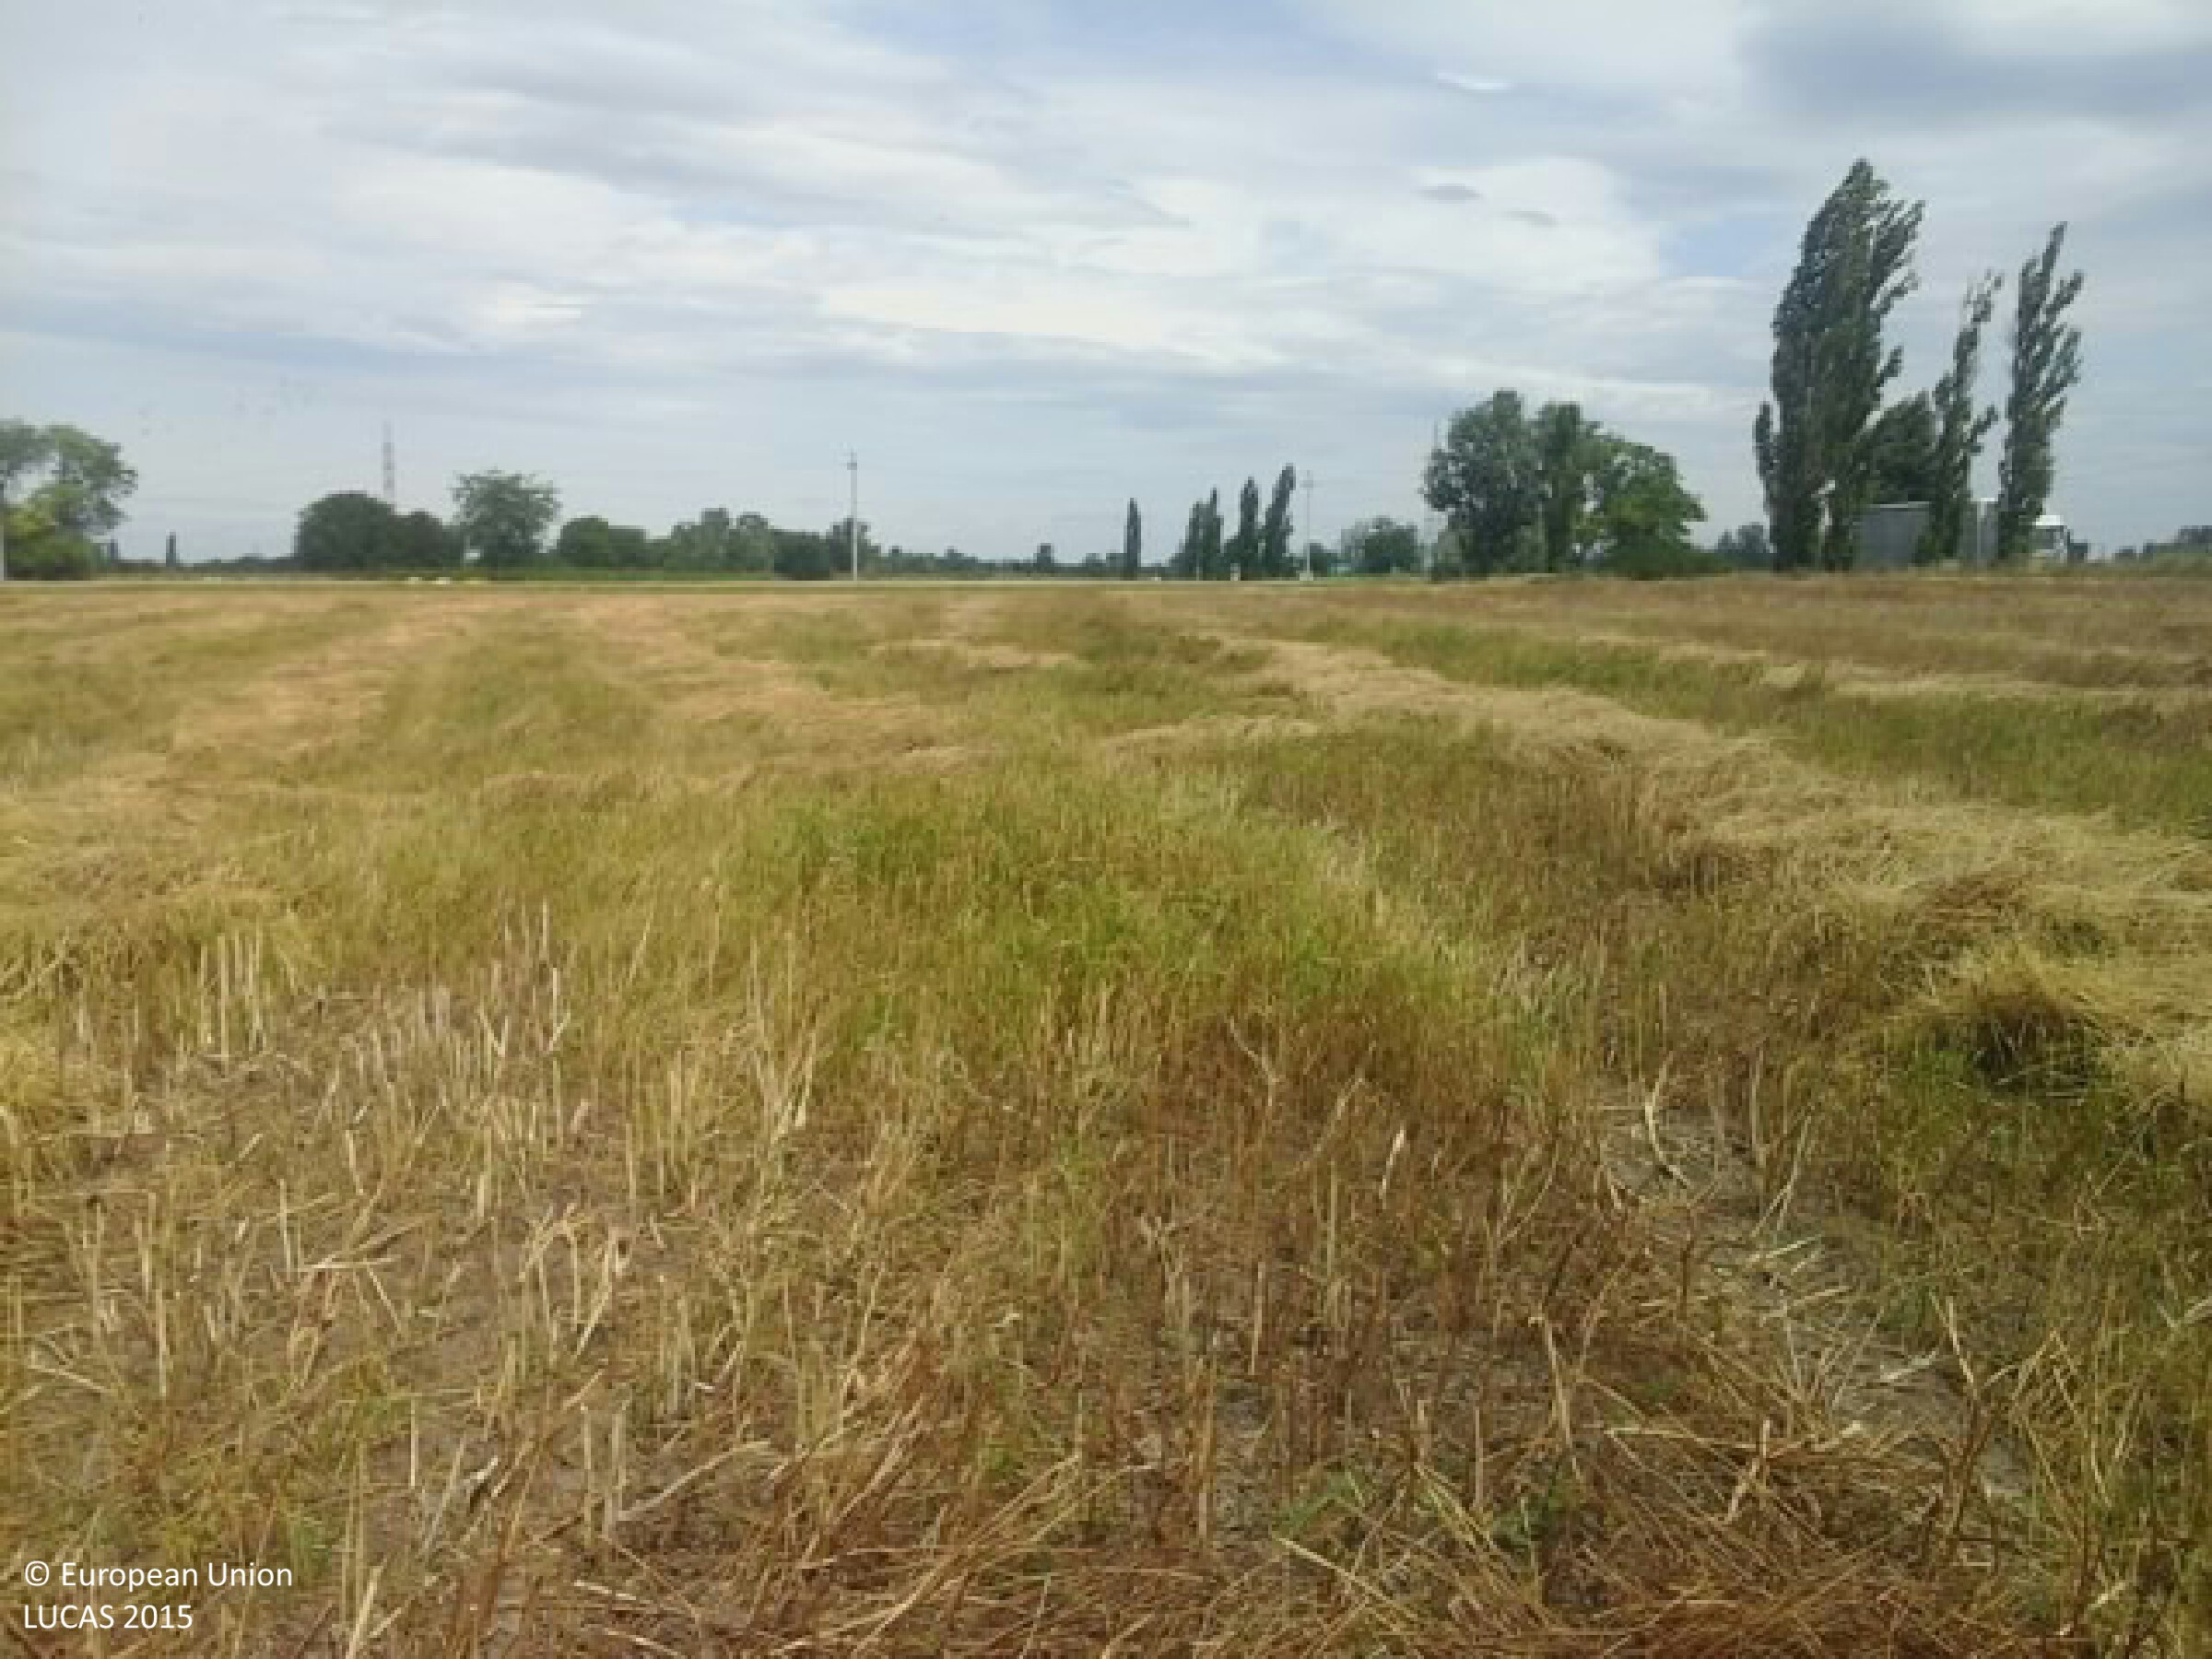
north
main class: Cropland
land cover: Rape and turnip rape
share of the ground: 25 - 50 %
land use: Agriculture (excluding fallow land and kitchen gardens)
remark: Harvested field
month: July
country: HU
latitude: 47.1489
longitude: 18.9970
